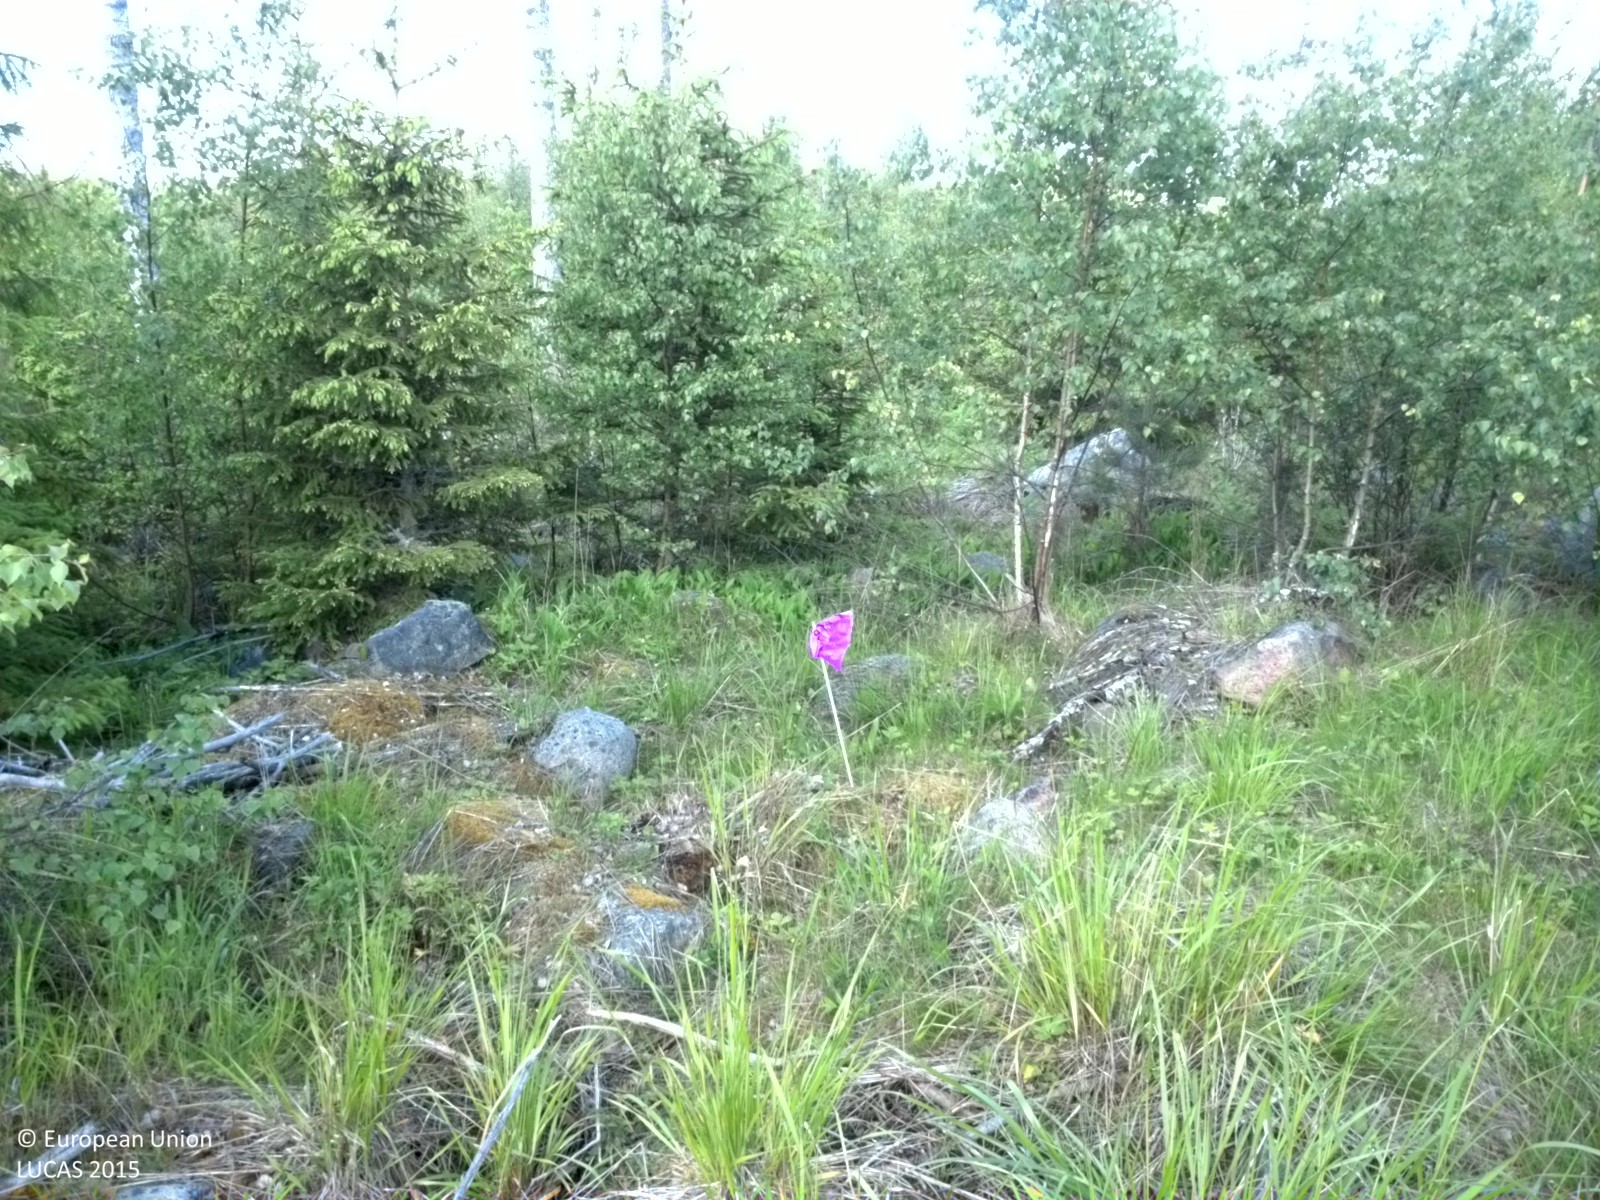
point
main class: Woodland
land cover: Spruce dominated mixed woodland
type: boreal forest
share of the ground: 50 - 75 %
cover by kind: broadleaved forest trees 30 %, coniferous forest trees 25 %, herbaceous plants 20 %, lichens and mosses 10 %, consolidated bare surface 10 %, shrubs 5 %
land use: Forestry
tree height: < 5 m
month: June
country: SE
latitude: 60.1500
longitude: 17.7204
